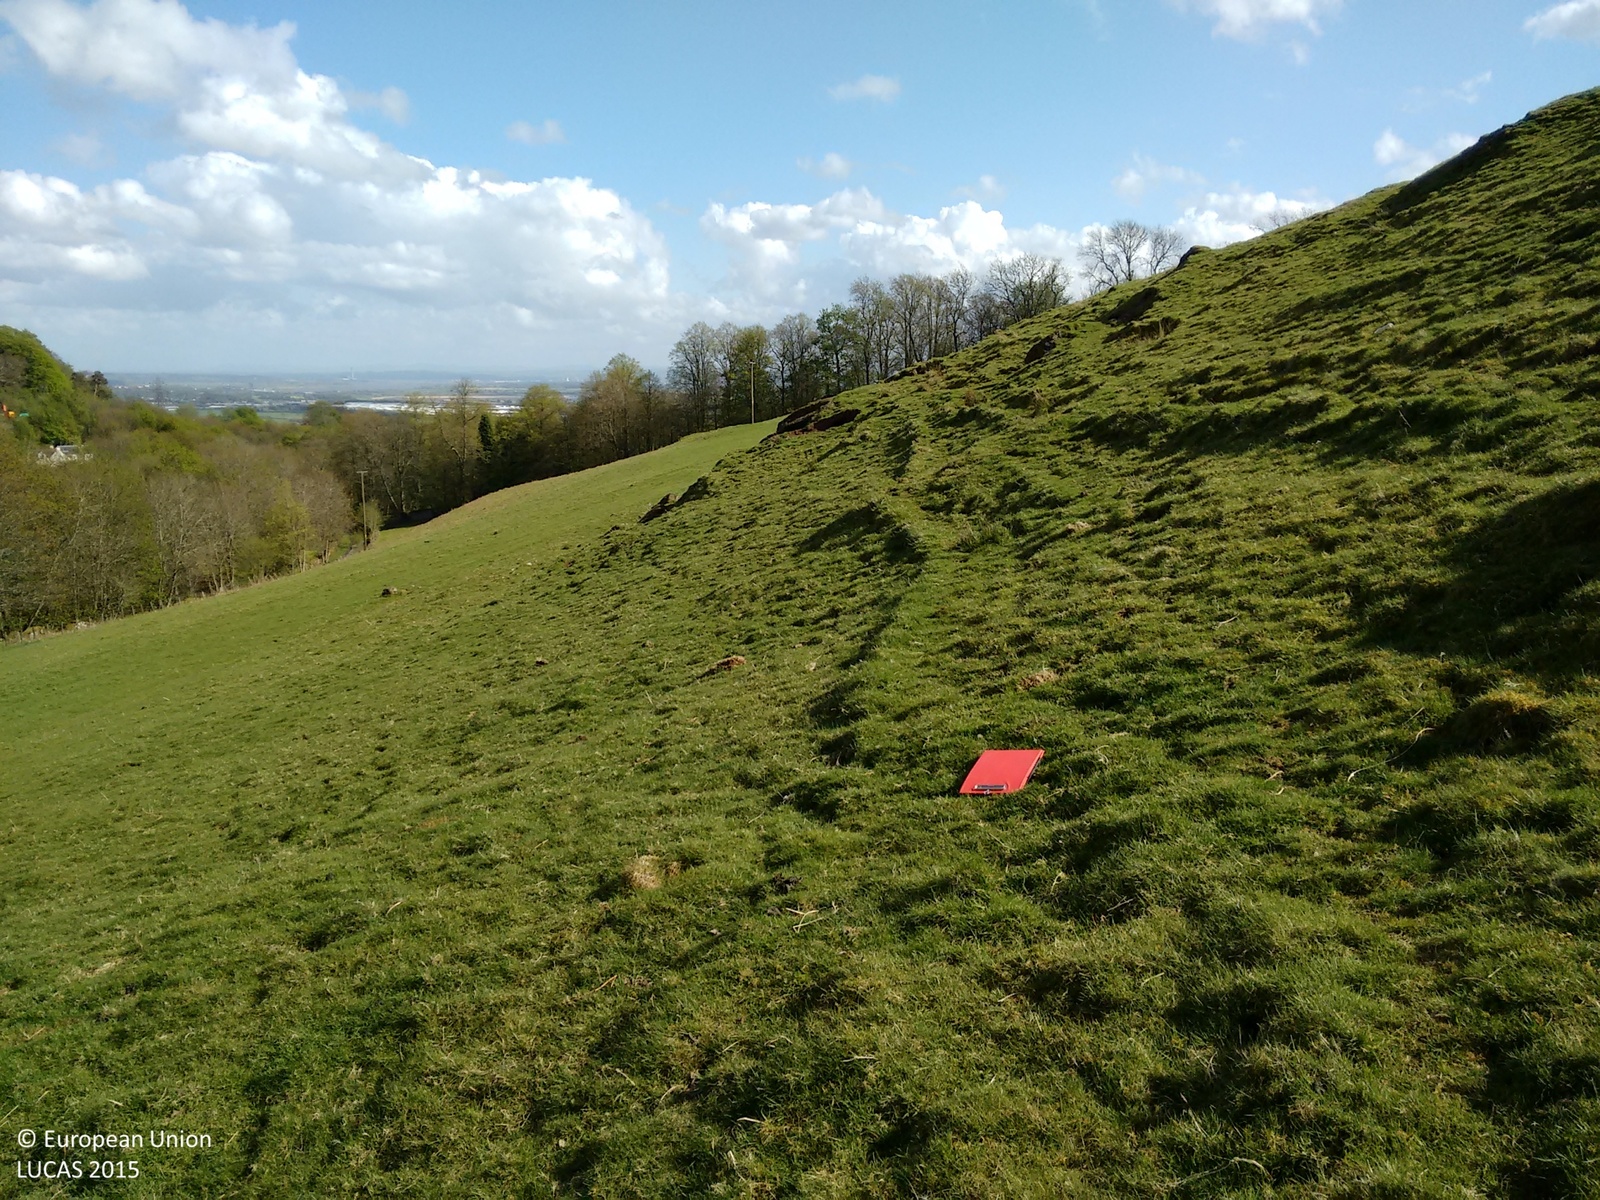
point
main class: Grassland
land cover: Grassland without tree/shrub cover
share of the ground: > 75 %
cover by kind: herbaceous plants 100 %
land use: Agriculture (excluding fallow land and kitchen gardens)
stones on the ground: < 10 %
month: May
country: GB
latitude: 56.1557
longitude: -3.9144
